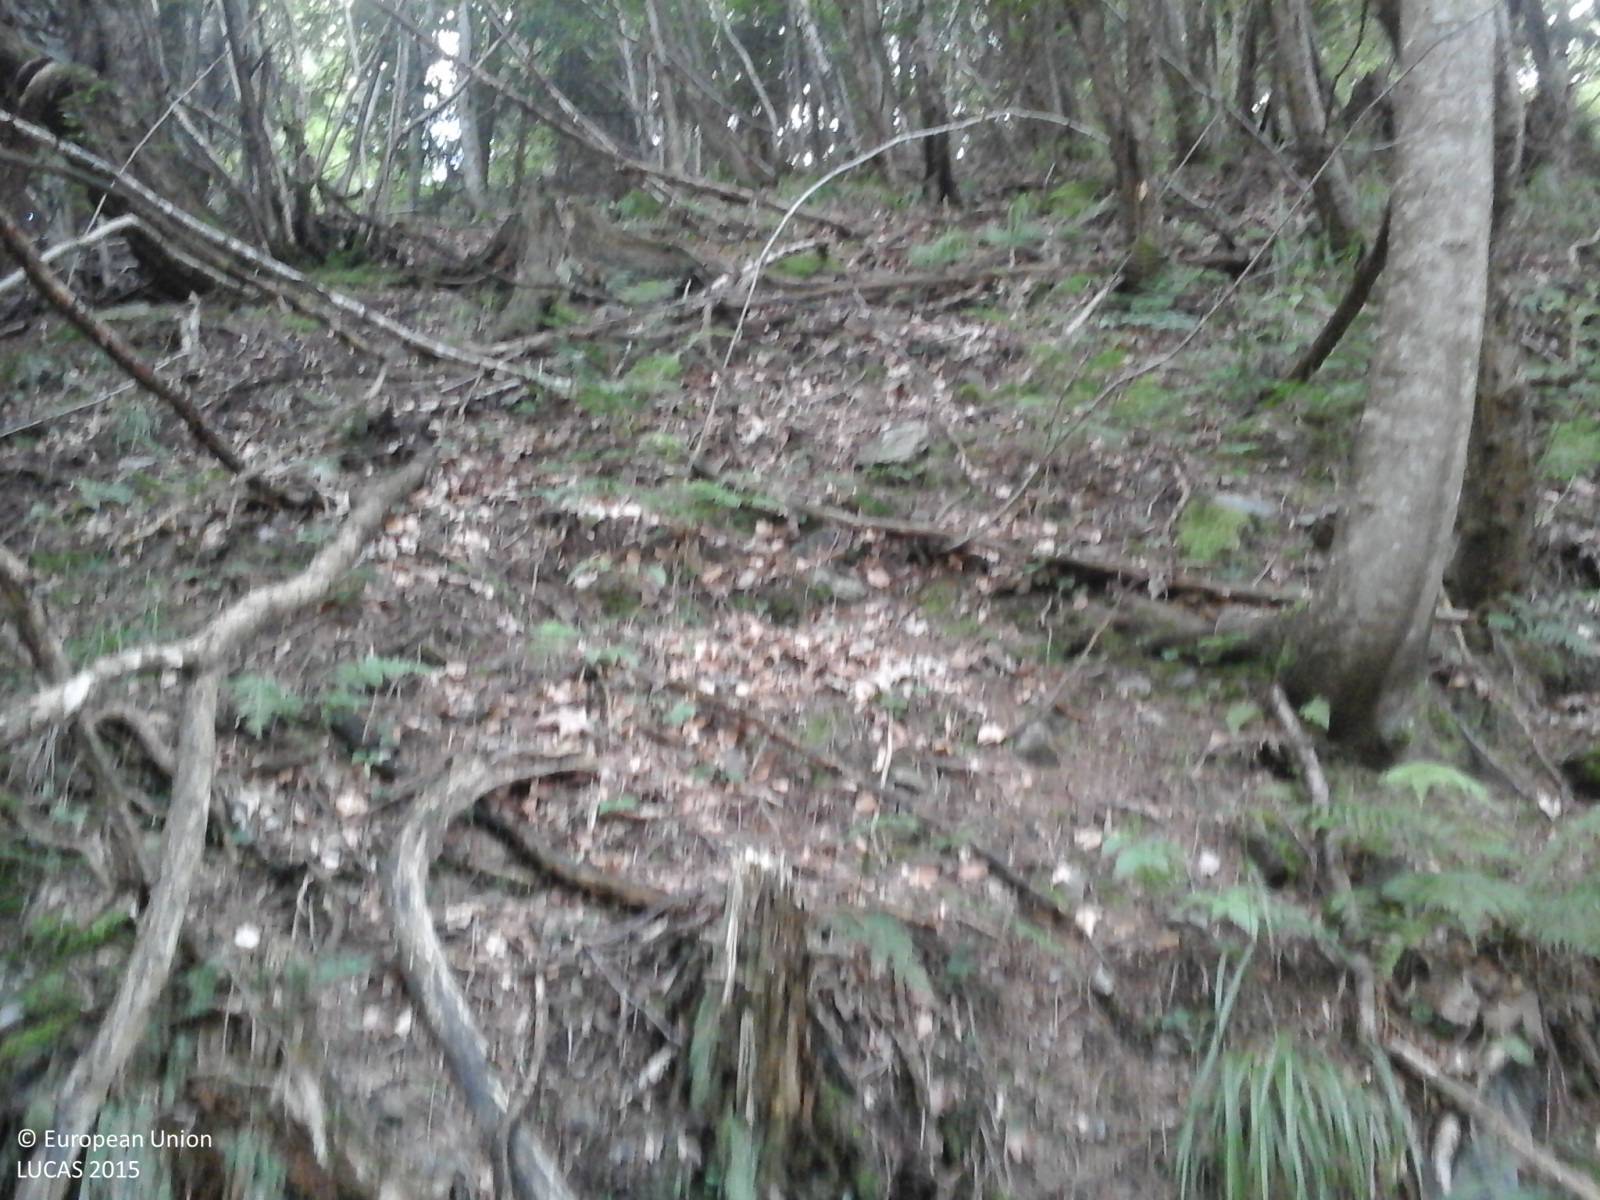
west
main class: Woodland
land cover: Other mixed woodland
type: mountainous beech forest
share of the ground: > 75 %
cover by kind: broadleaved forest trees 60 %, coniferous forest trees 40 %
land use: Forestry
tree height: > 5 m
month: July
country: IT
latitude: 46.5799
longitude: 12.9855
